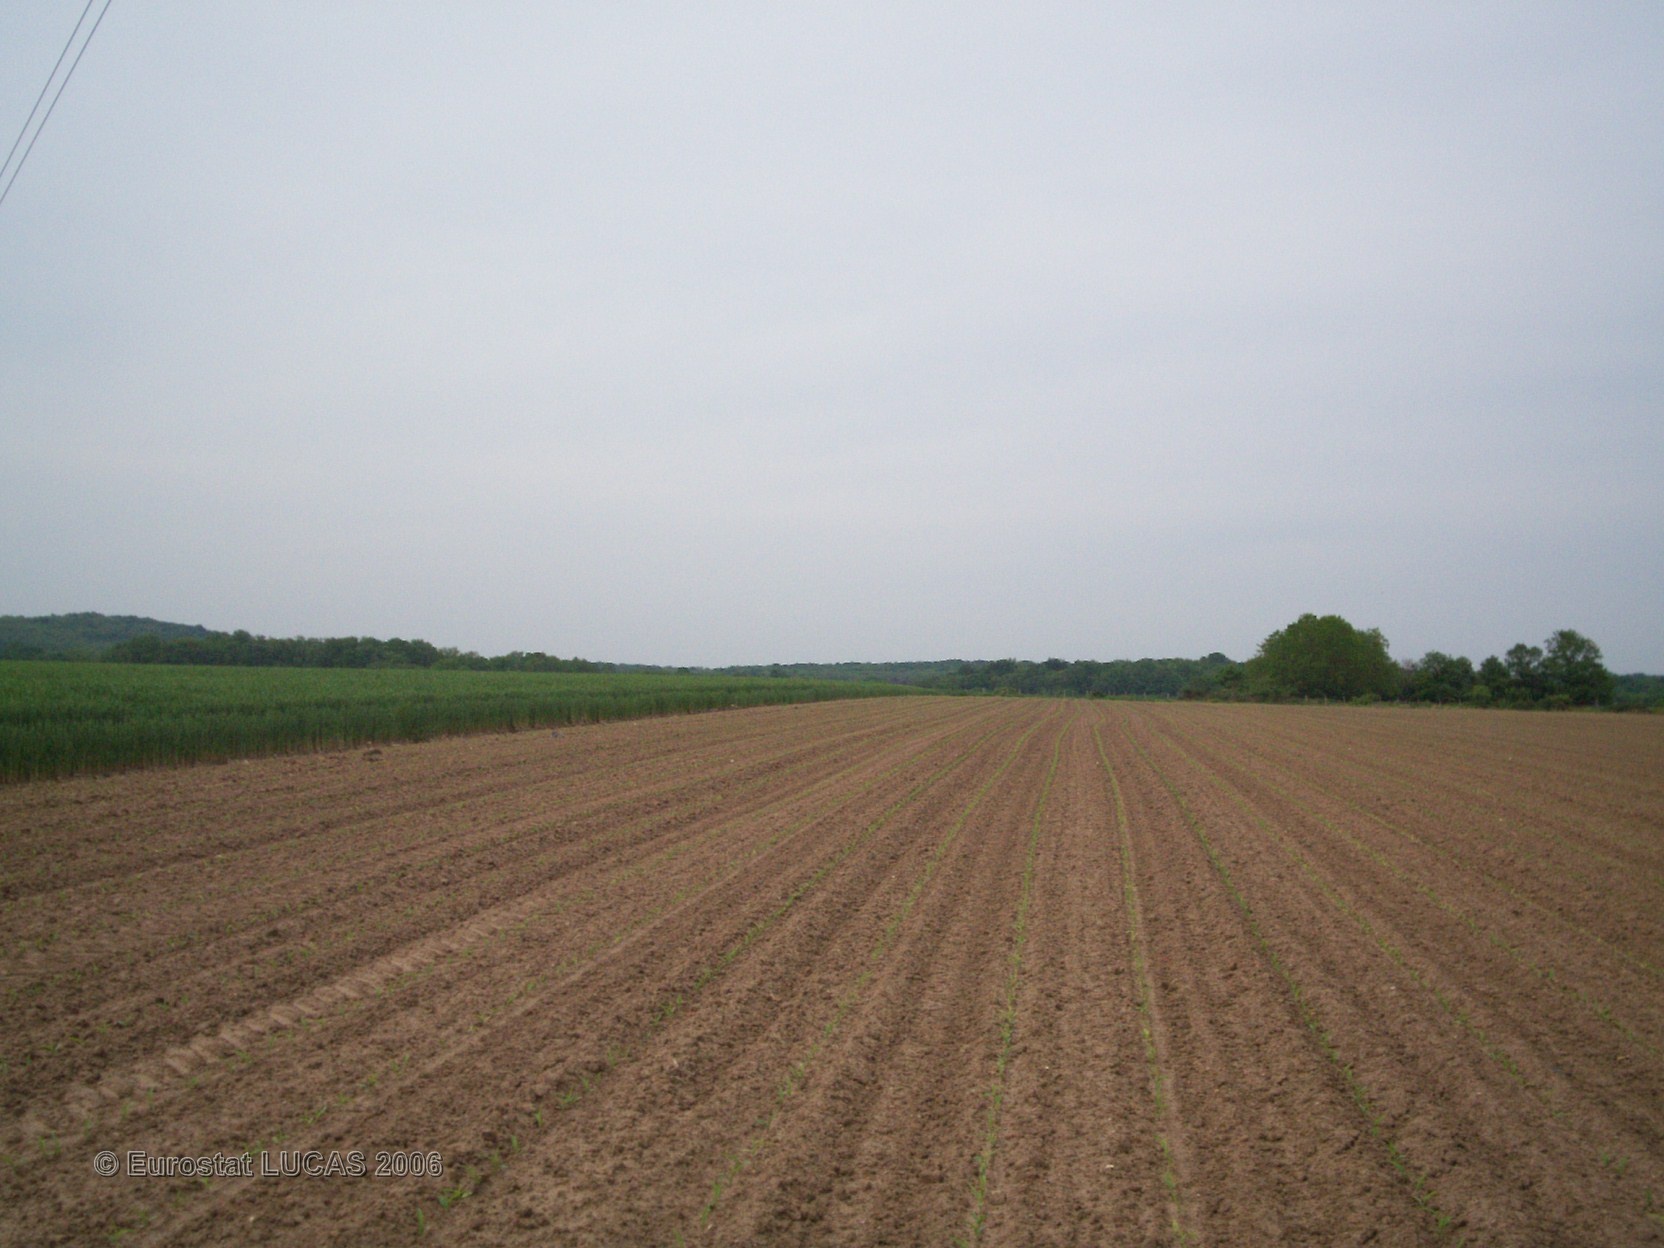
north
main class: Cropland
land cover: Maize
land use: Agriculture (excluding fallow land and kitchen gardens)
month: May
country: FR
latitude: 46.6534
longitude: 4.7092
